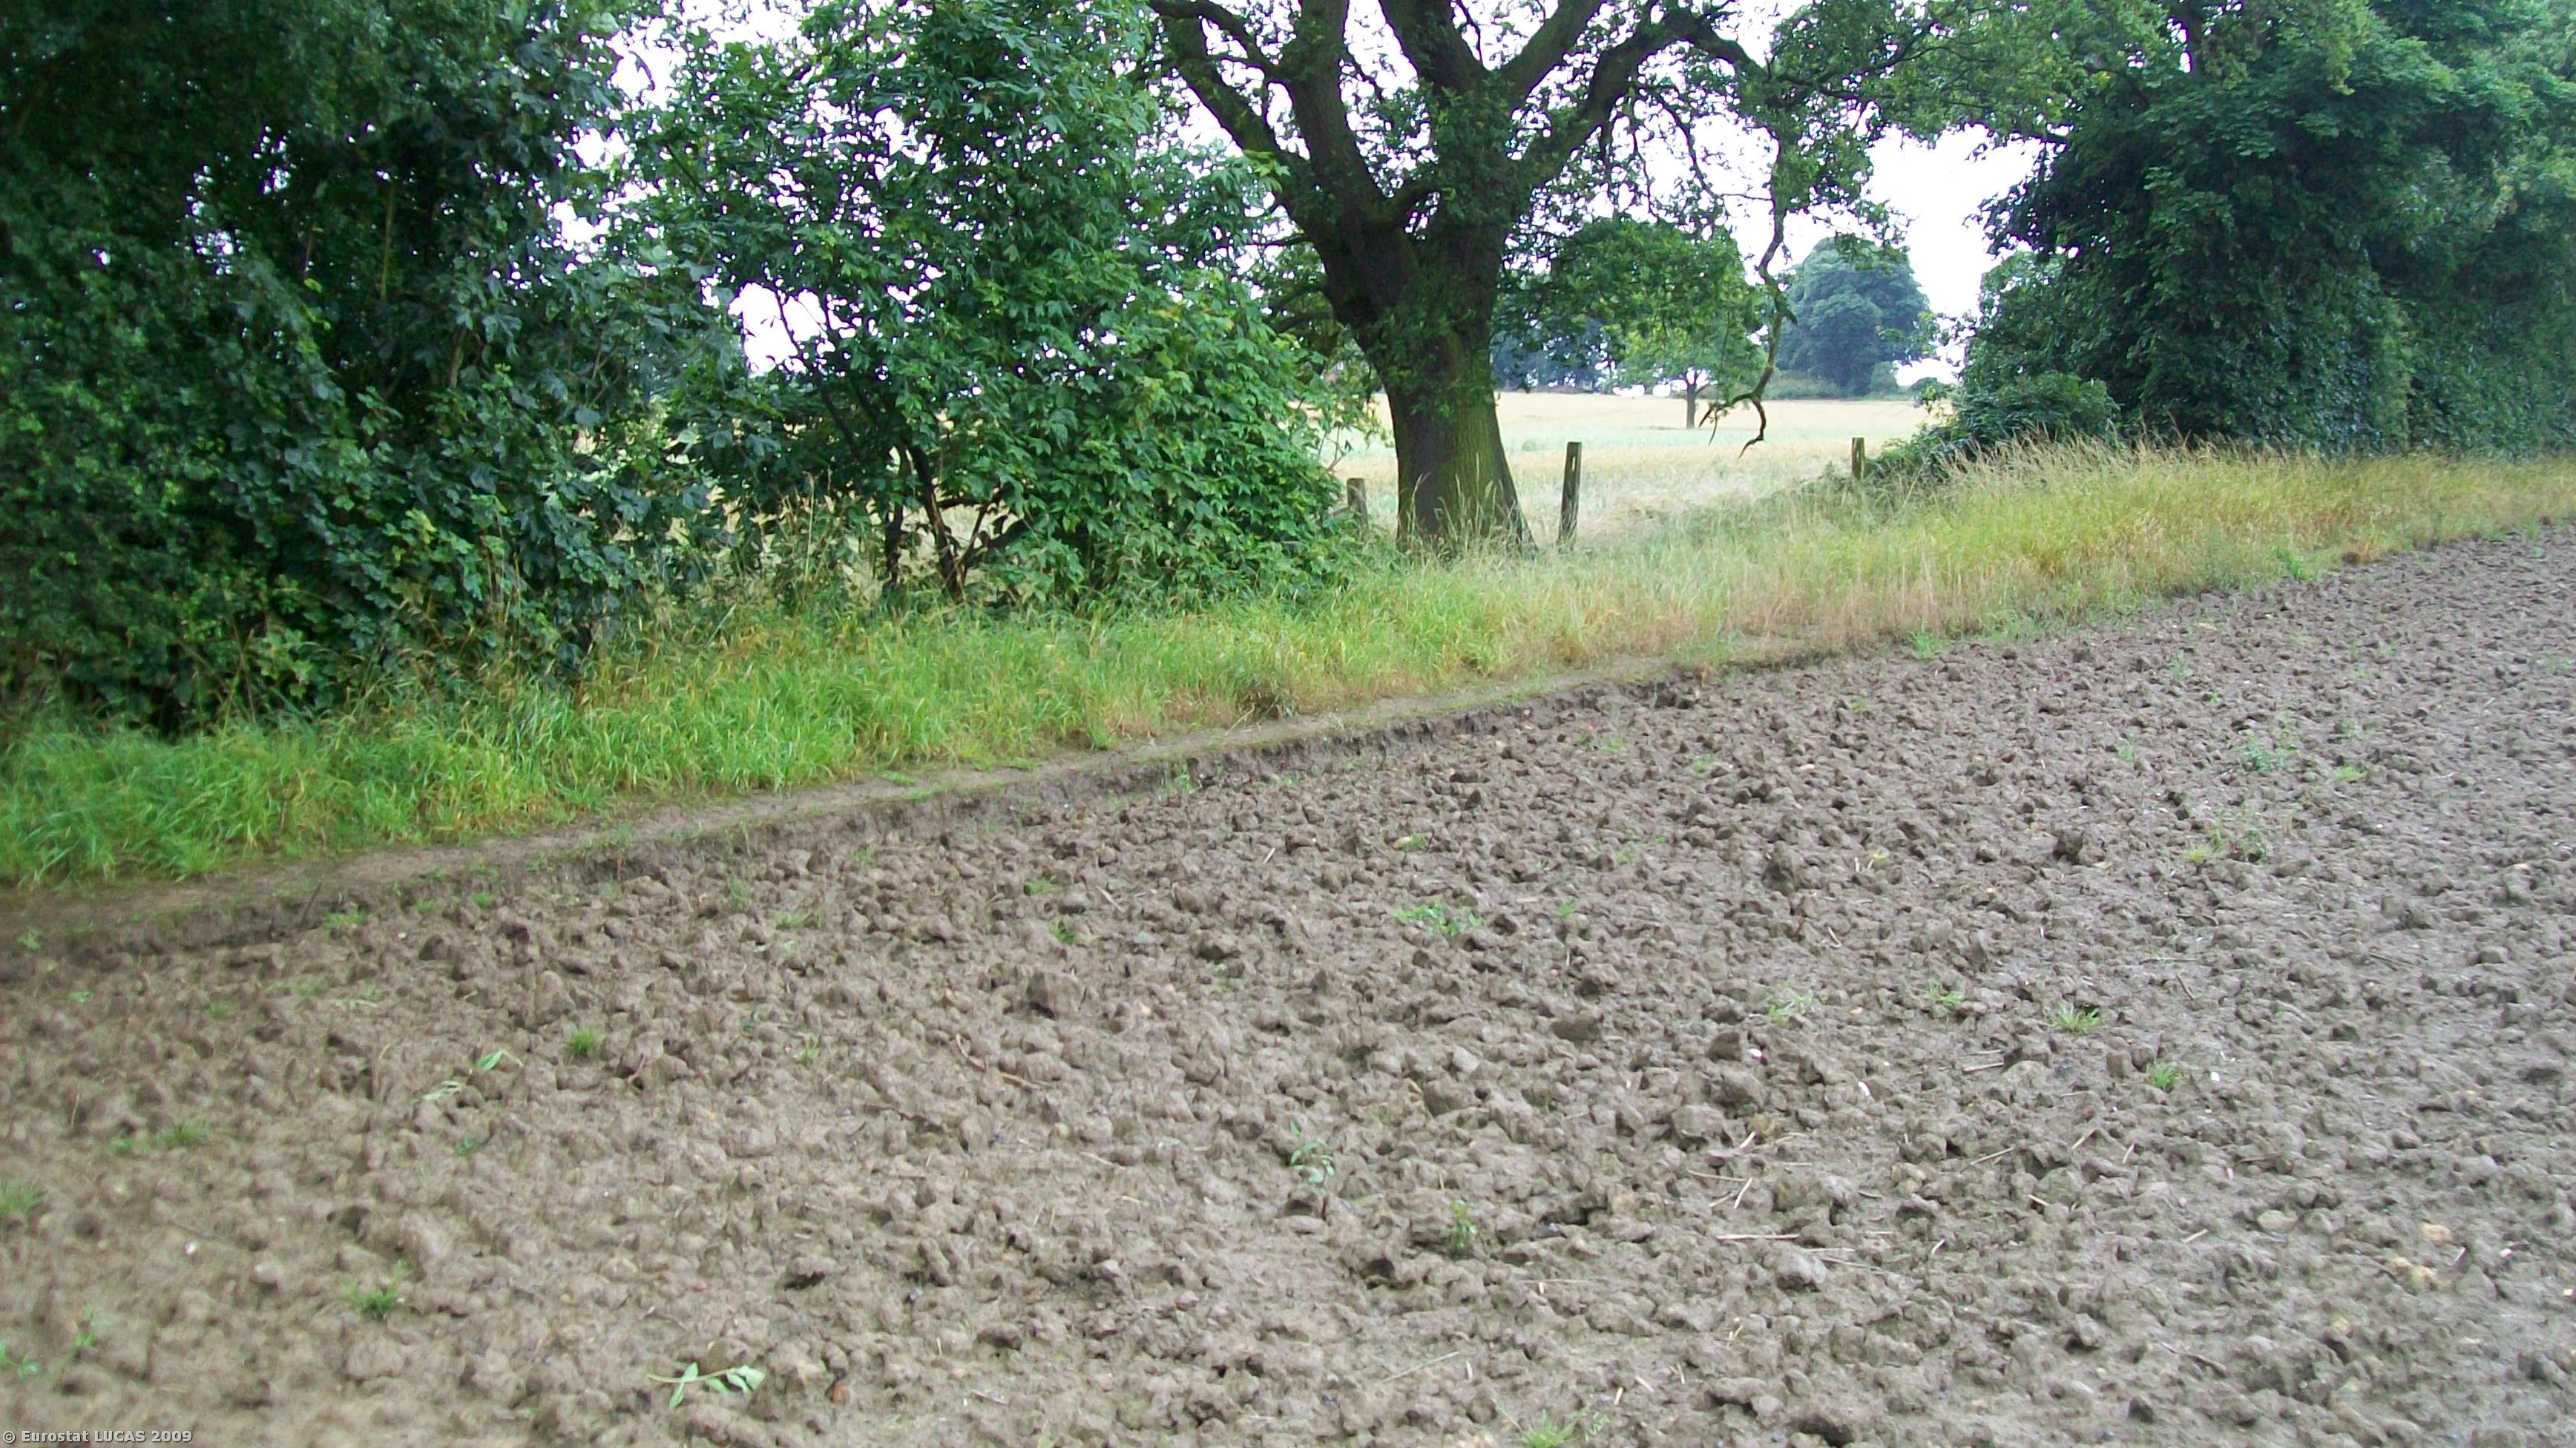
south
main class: Cropland
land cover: Common wheat
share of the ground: > 75 %
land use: Agriculture (excluding fallow land and kitchen gardens)
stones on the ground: 10 - 25 %
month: July
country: GB
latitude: 52.7662
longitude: -1.4470
